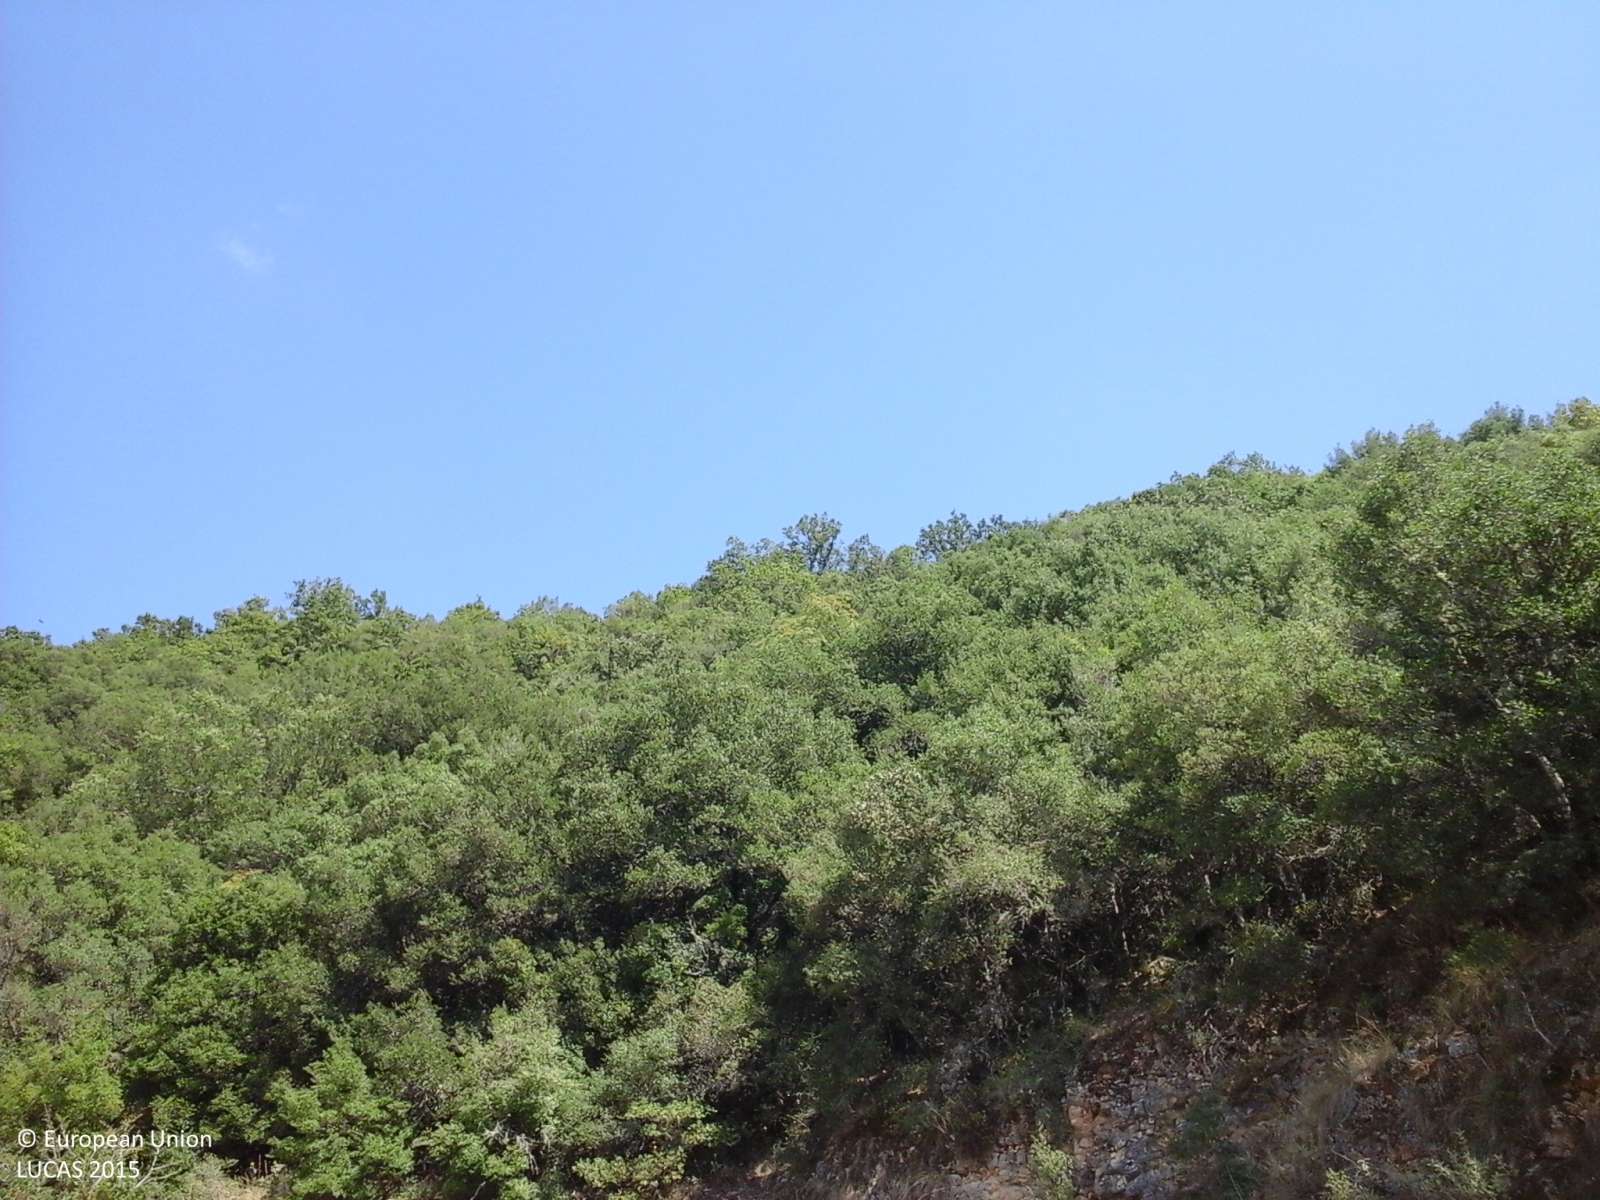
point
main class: Shrubland
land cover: Shrubland with sparse tree cover
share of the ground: > 75 %
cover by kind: shrubs 95 %, broadleaved forest trees 5 %
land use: Agriculture (excluding fallow land and kitchen gardens)
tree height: < 5 m
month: September
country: GR
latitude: 39.6297
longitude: 20.4967
